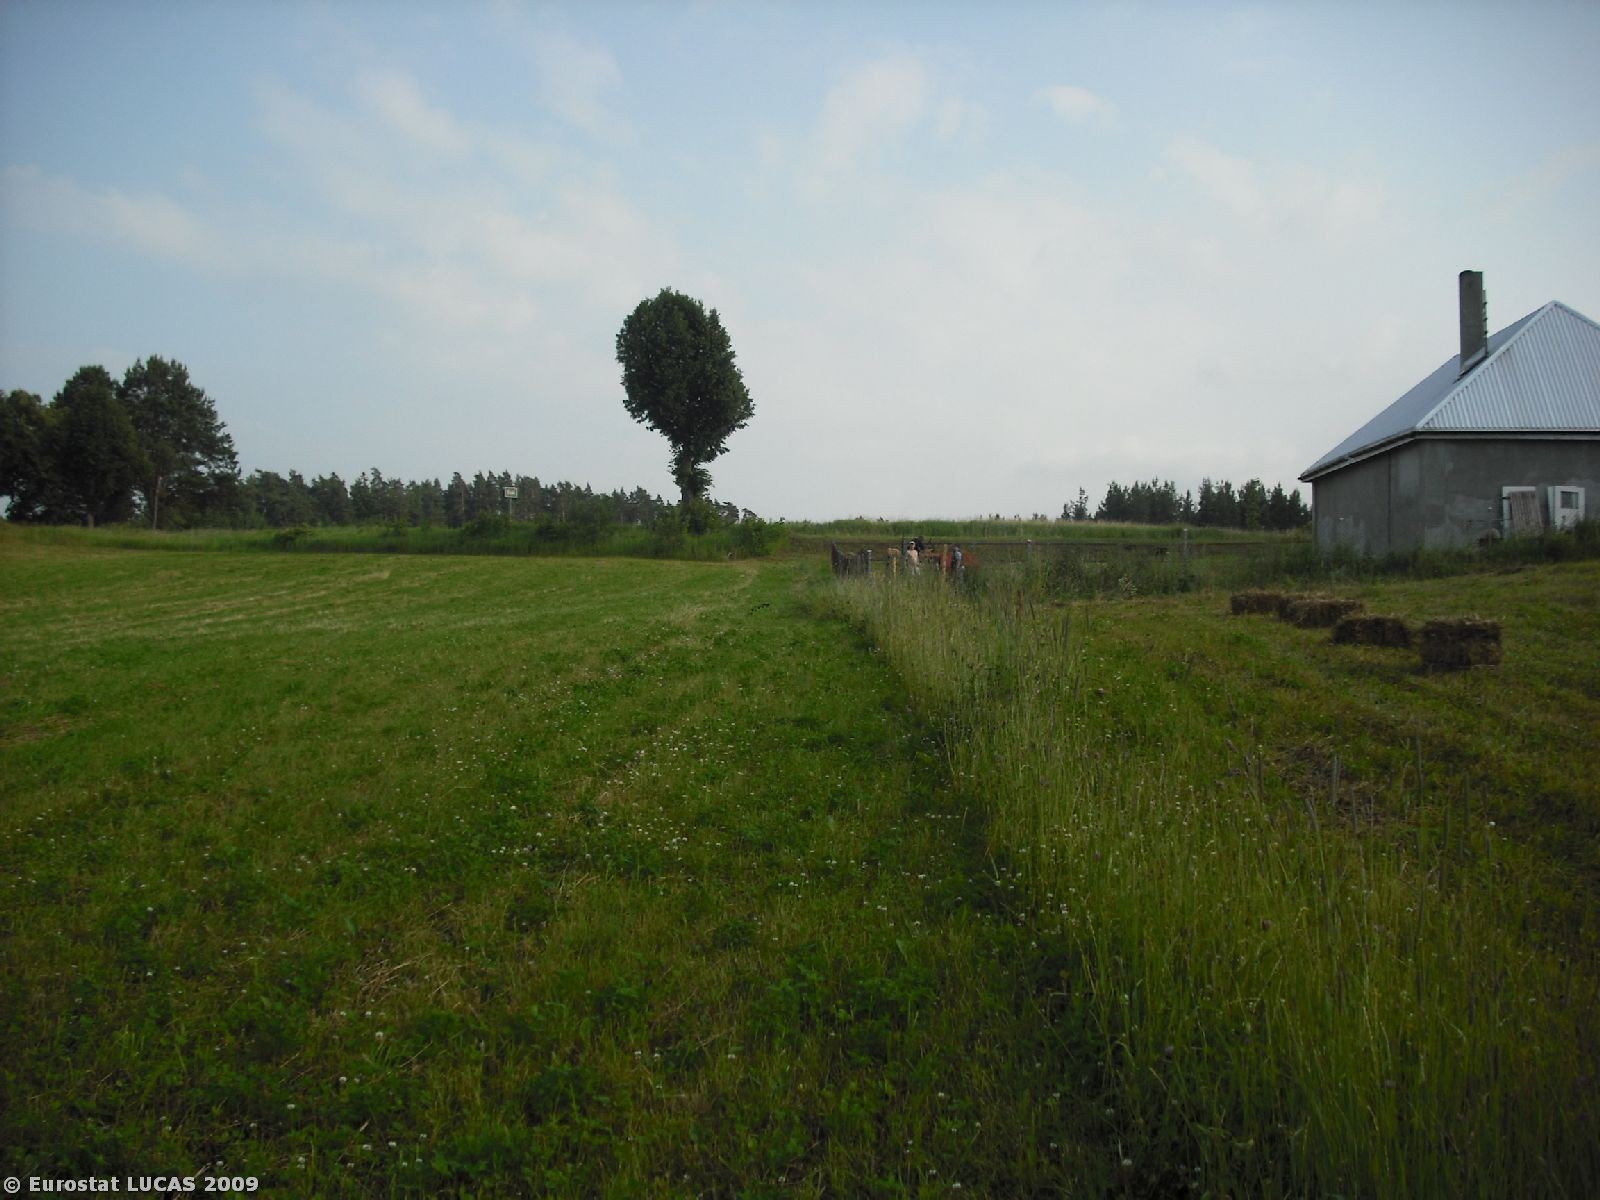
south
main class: Grassland
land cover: Grassland without tree/shrub cover
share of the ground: > 75 %
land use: Agriculture (excluding fallow land and kitchen gardens)
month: June
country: PL
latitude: 53.9396
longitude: 22.4489
